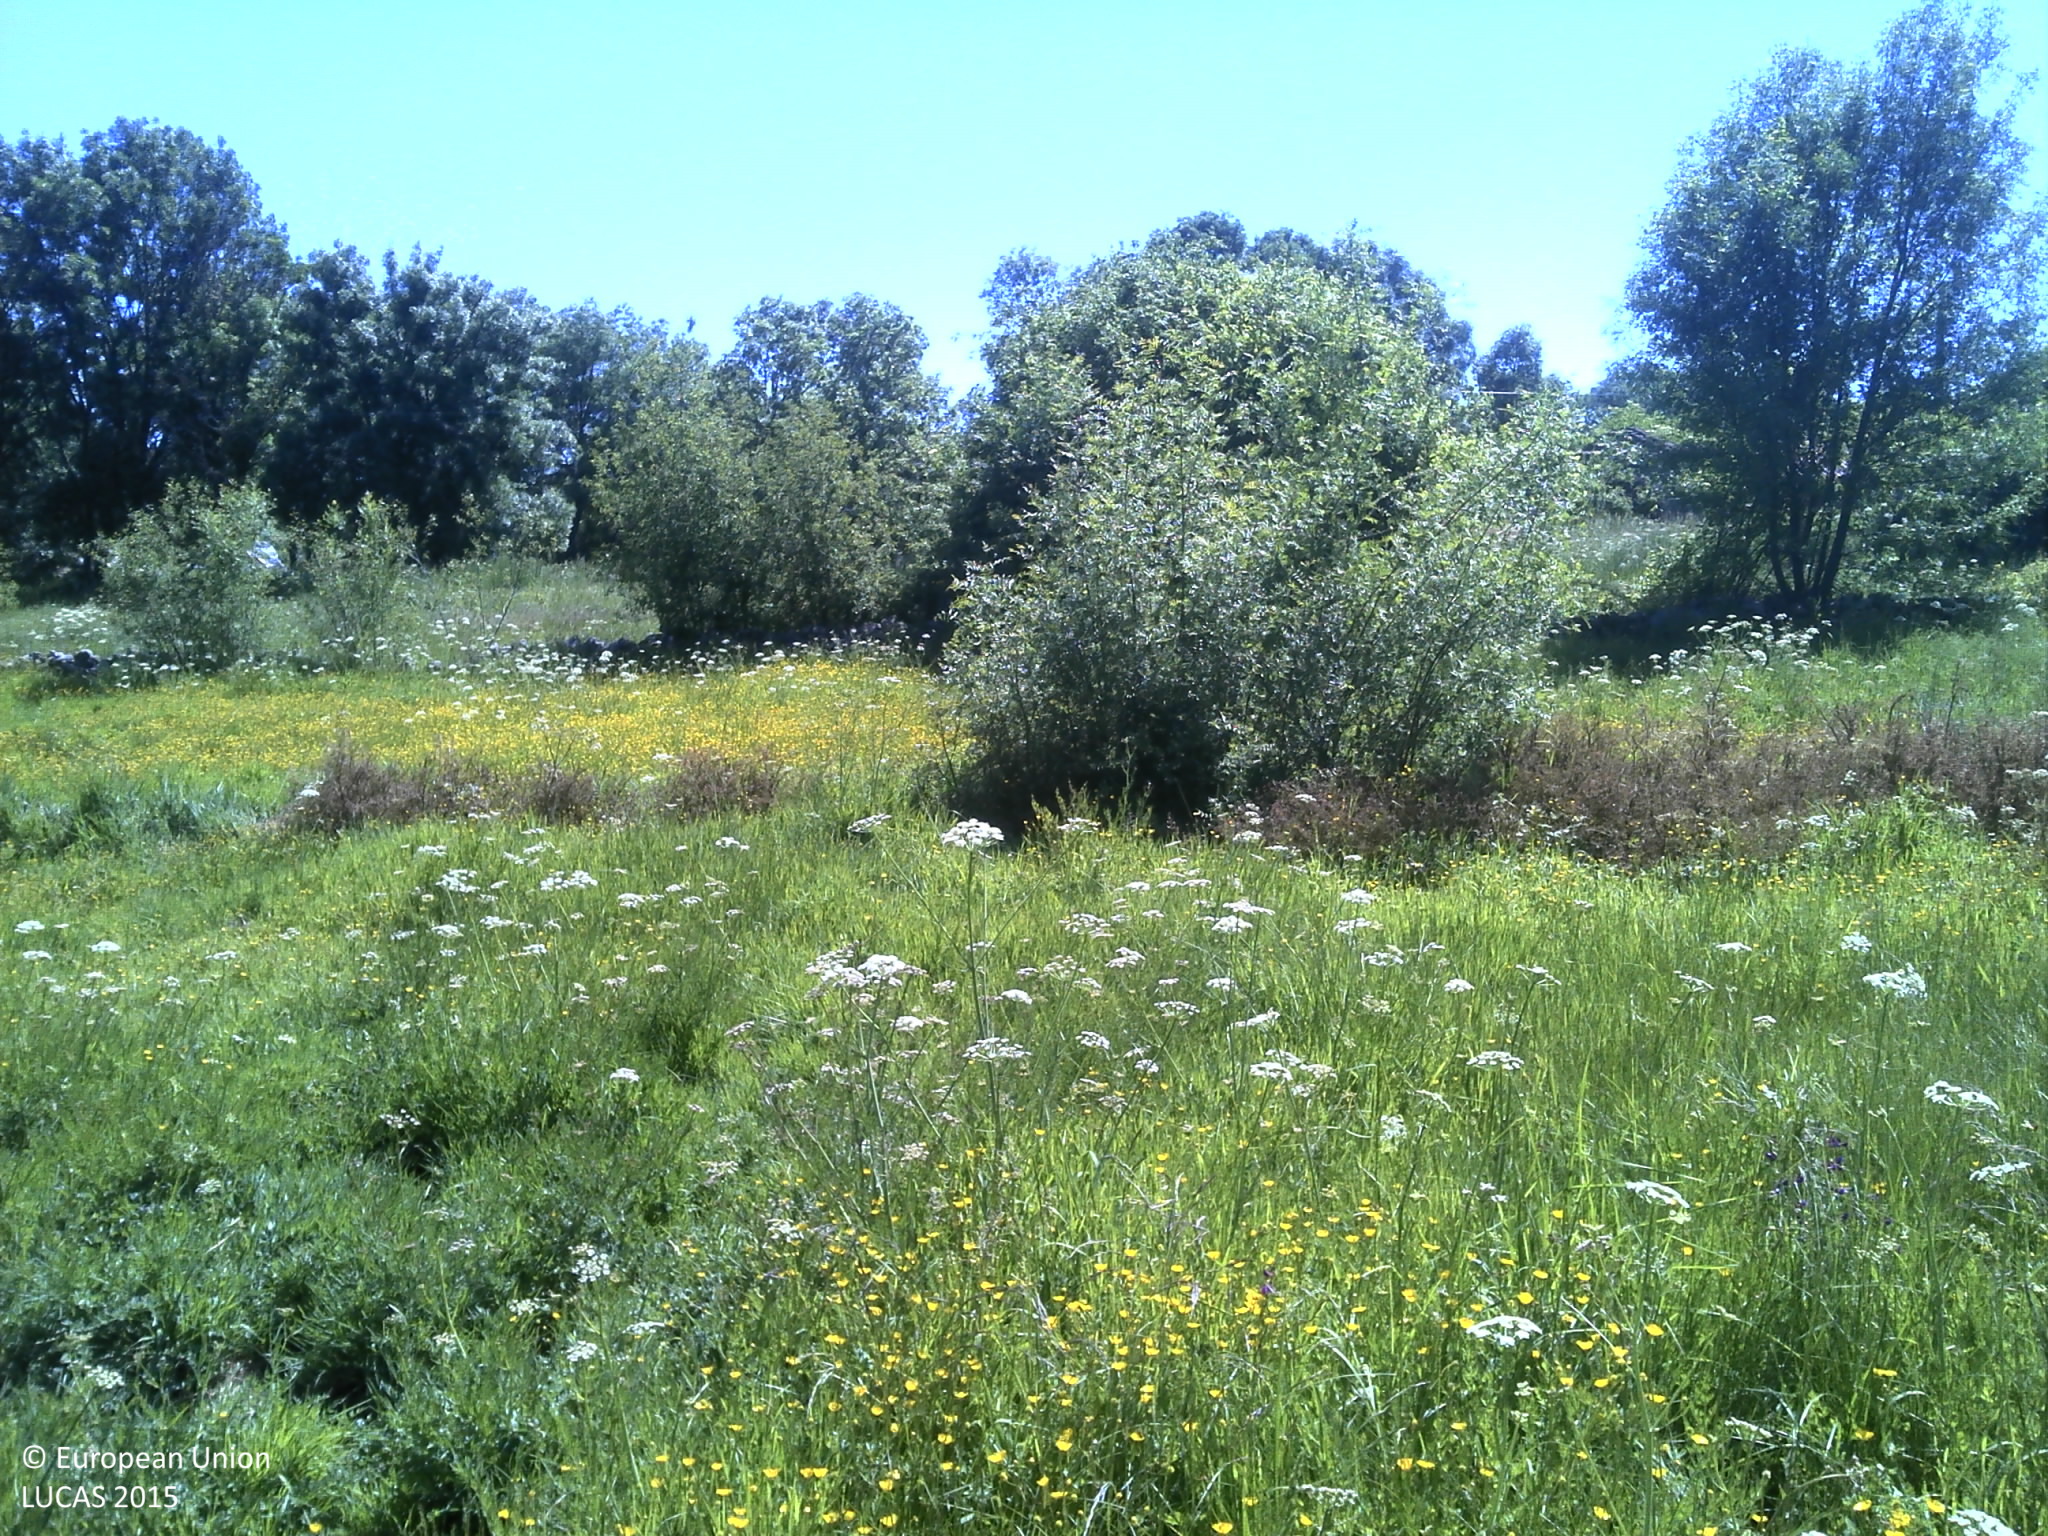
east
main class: Grassland
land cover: Grassland without tree/shrub cover
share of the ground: 50 - 75 %
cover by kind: herbaceous plants 65 %, unconsolidated bare surface 25 %, shrubs 5 %
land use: Agriculture (excluding fallow land and kitchen gardens)
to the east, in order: Grassland without tree/shrub cover; Electric lines; Grassland without tree/shrub cover; Dry stone walls; Grassland without tree/shrub cover; Electric lines; Dry stone walls; Single bushes/trees; Grassland without tree/shrub cover; Dry stone walls; Grassland with sparse tree/shrub cover; Dry stone walls; Abandoned hedges; Grassland without tree/shrub cover; Dry stone walls; Abandoned hedges; Grassland without tree/shrub cover; Tracks; Grassland without tree/shrub cover; Dry stone walls; Oats; Abandoned hedges; Oats; Broadleaved woodland; Dry stone walls; Tracks; Dry stone walls; Shrubland without tree cover; Rocks and stones; Shrubland without tree cover
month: May
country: PT
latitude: 40.5962
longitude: -7.1071
